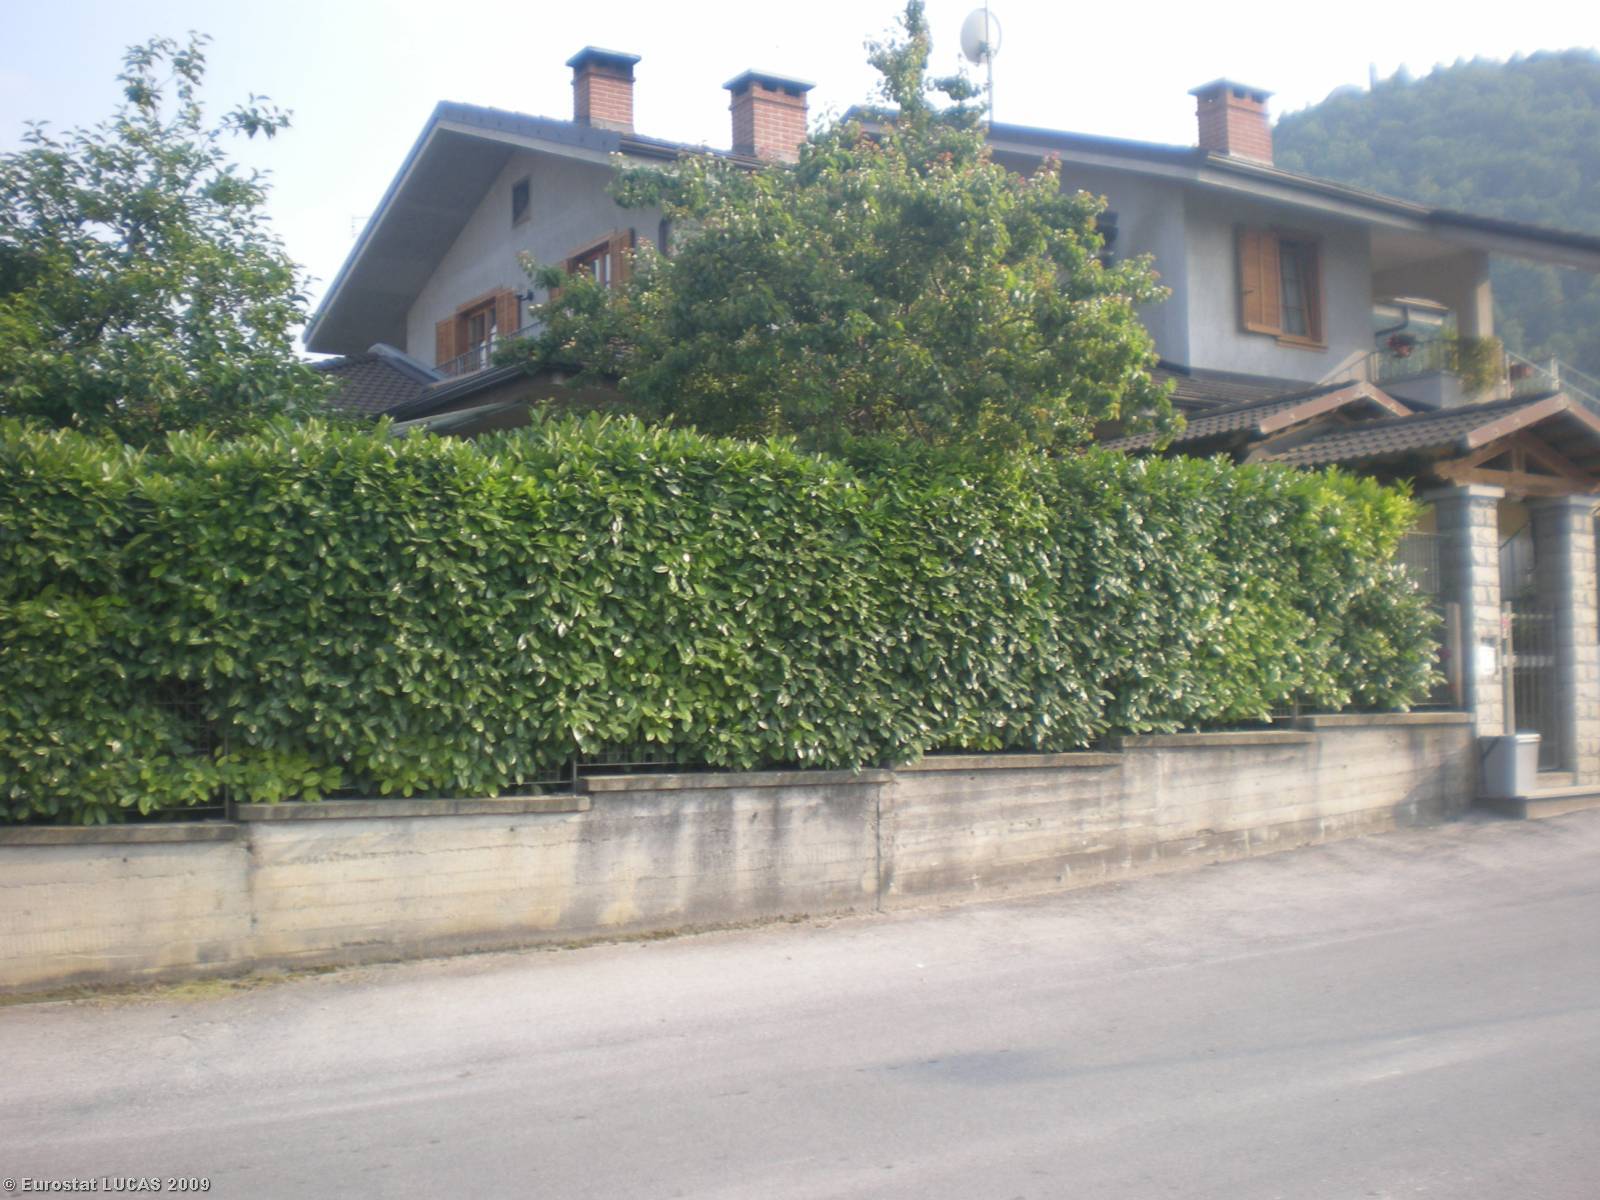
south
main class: Bare land
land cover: Bare land
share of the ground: > 75 %
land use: Residential
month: June
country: IT
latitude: 44.3910
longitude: 7.4319
